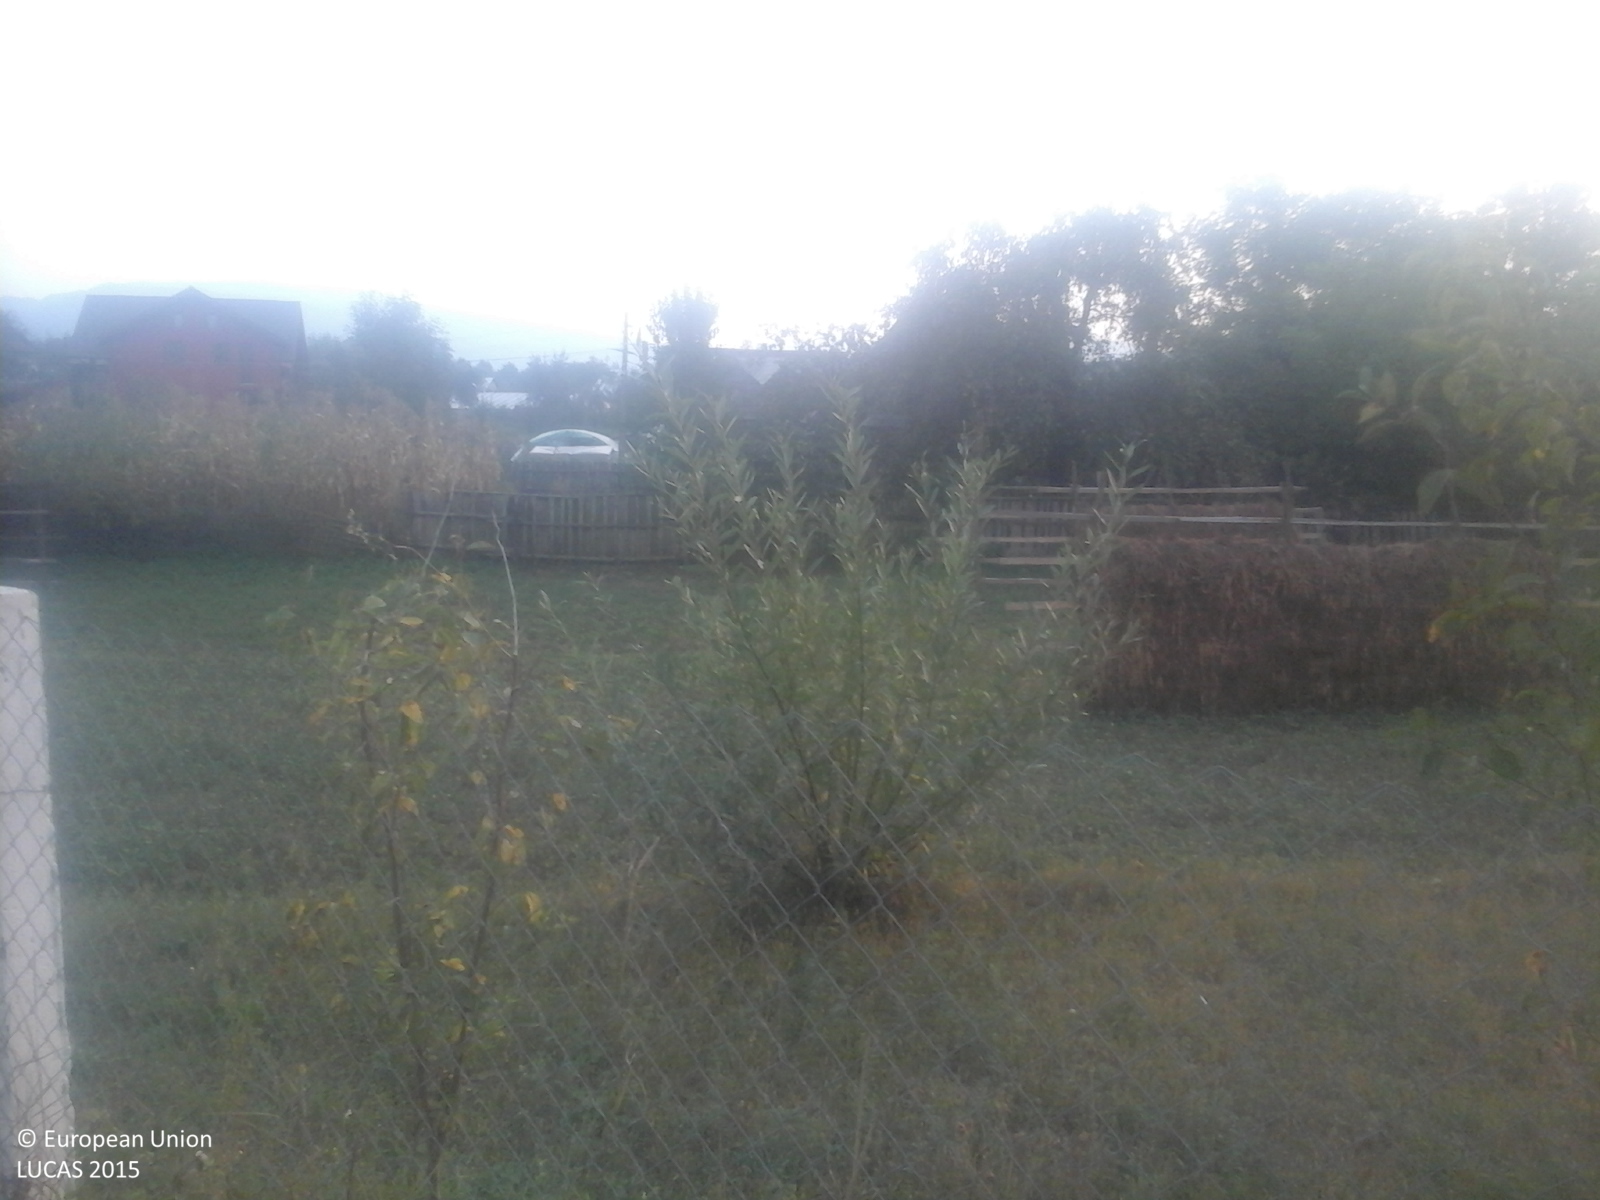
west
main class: Cropland
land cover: Lucerne
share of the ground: > 75 %
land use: Agriculture (excluding fallow land and kitchen gardens)
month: September
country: RO
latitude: 47.6934
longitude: 24.2530
